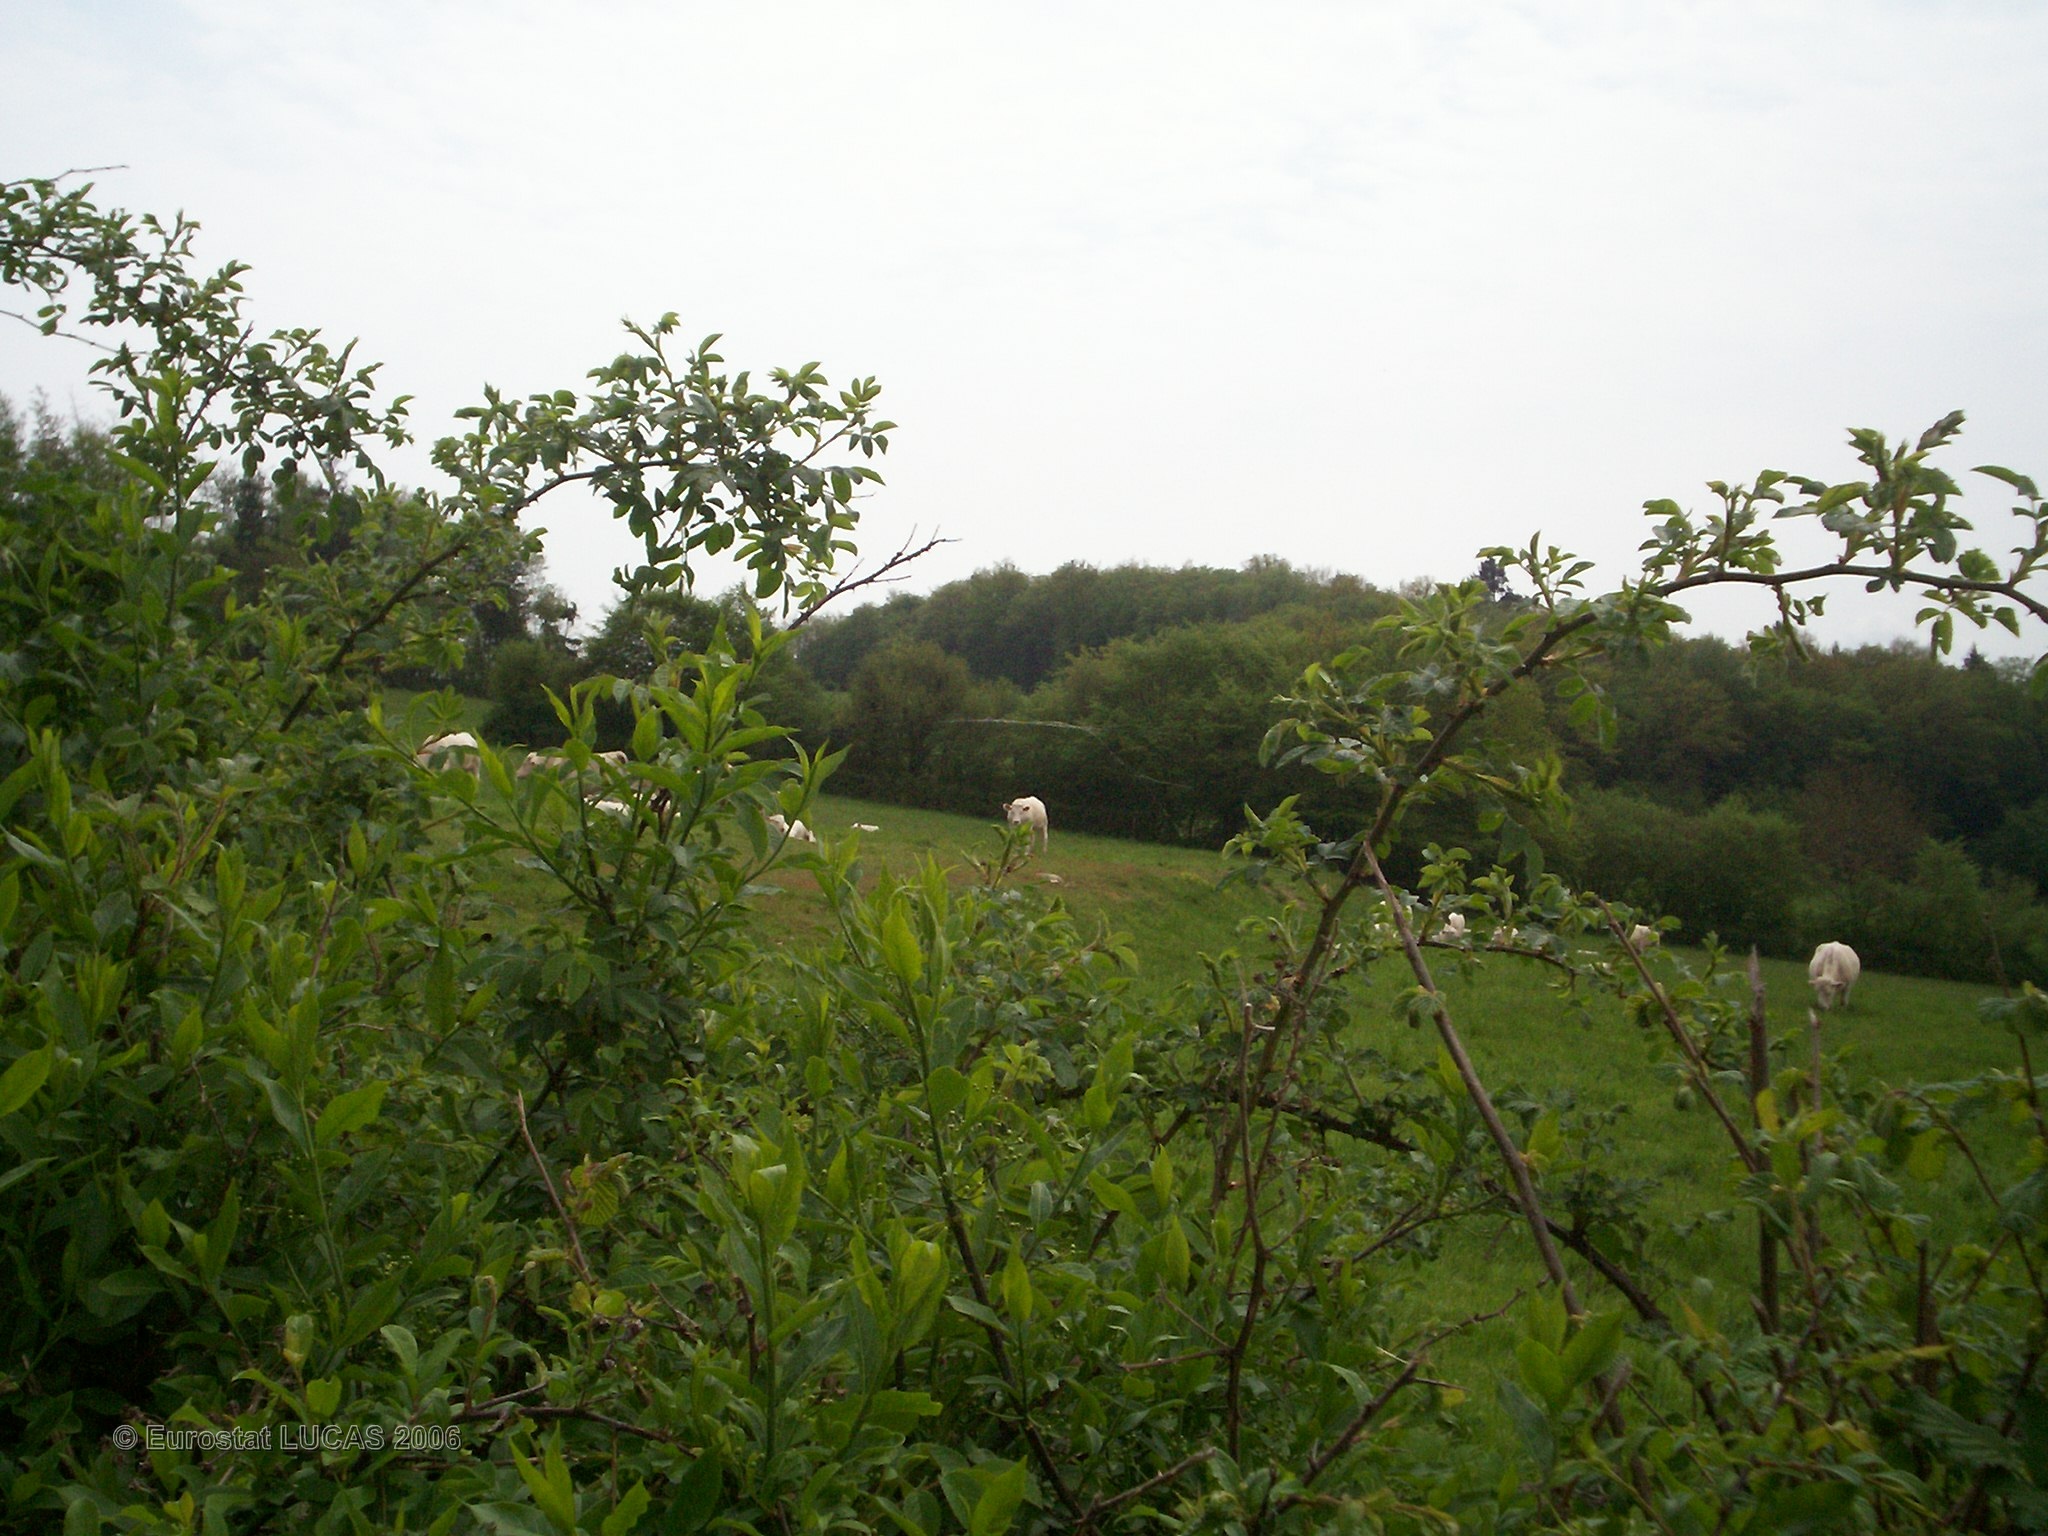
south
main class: Grassland
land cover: Grassland without tree/shrub cover
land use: Agriculture (excluding fallow land and kitchen gardens)
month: May
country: FR
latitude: 47.4043
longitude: 3.8889
